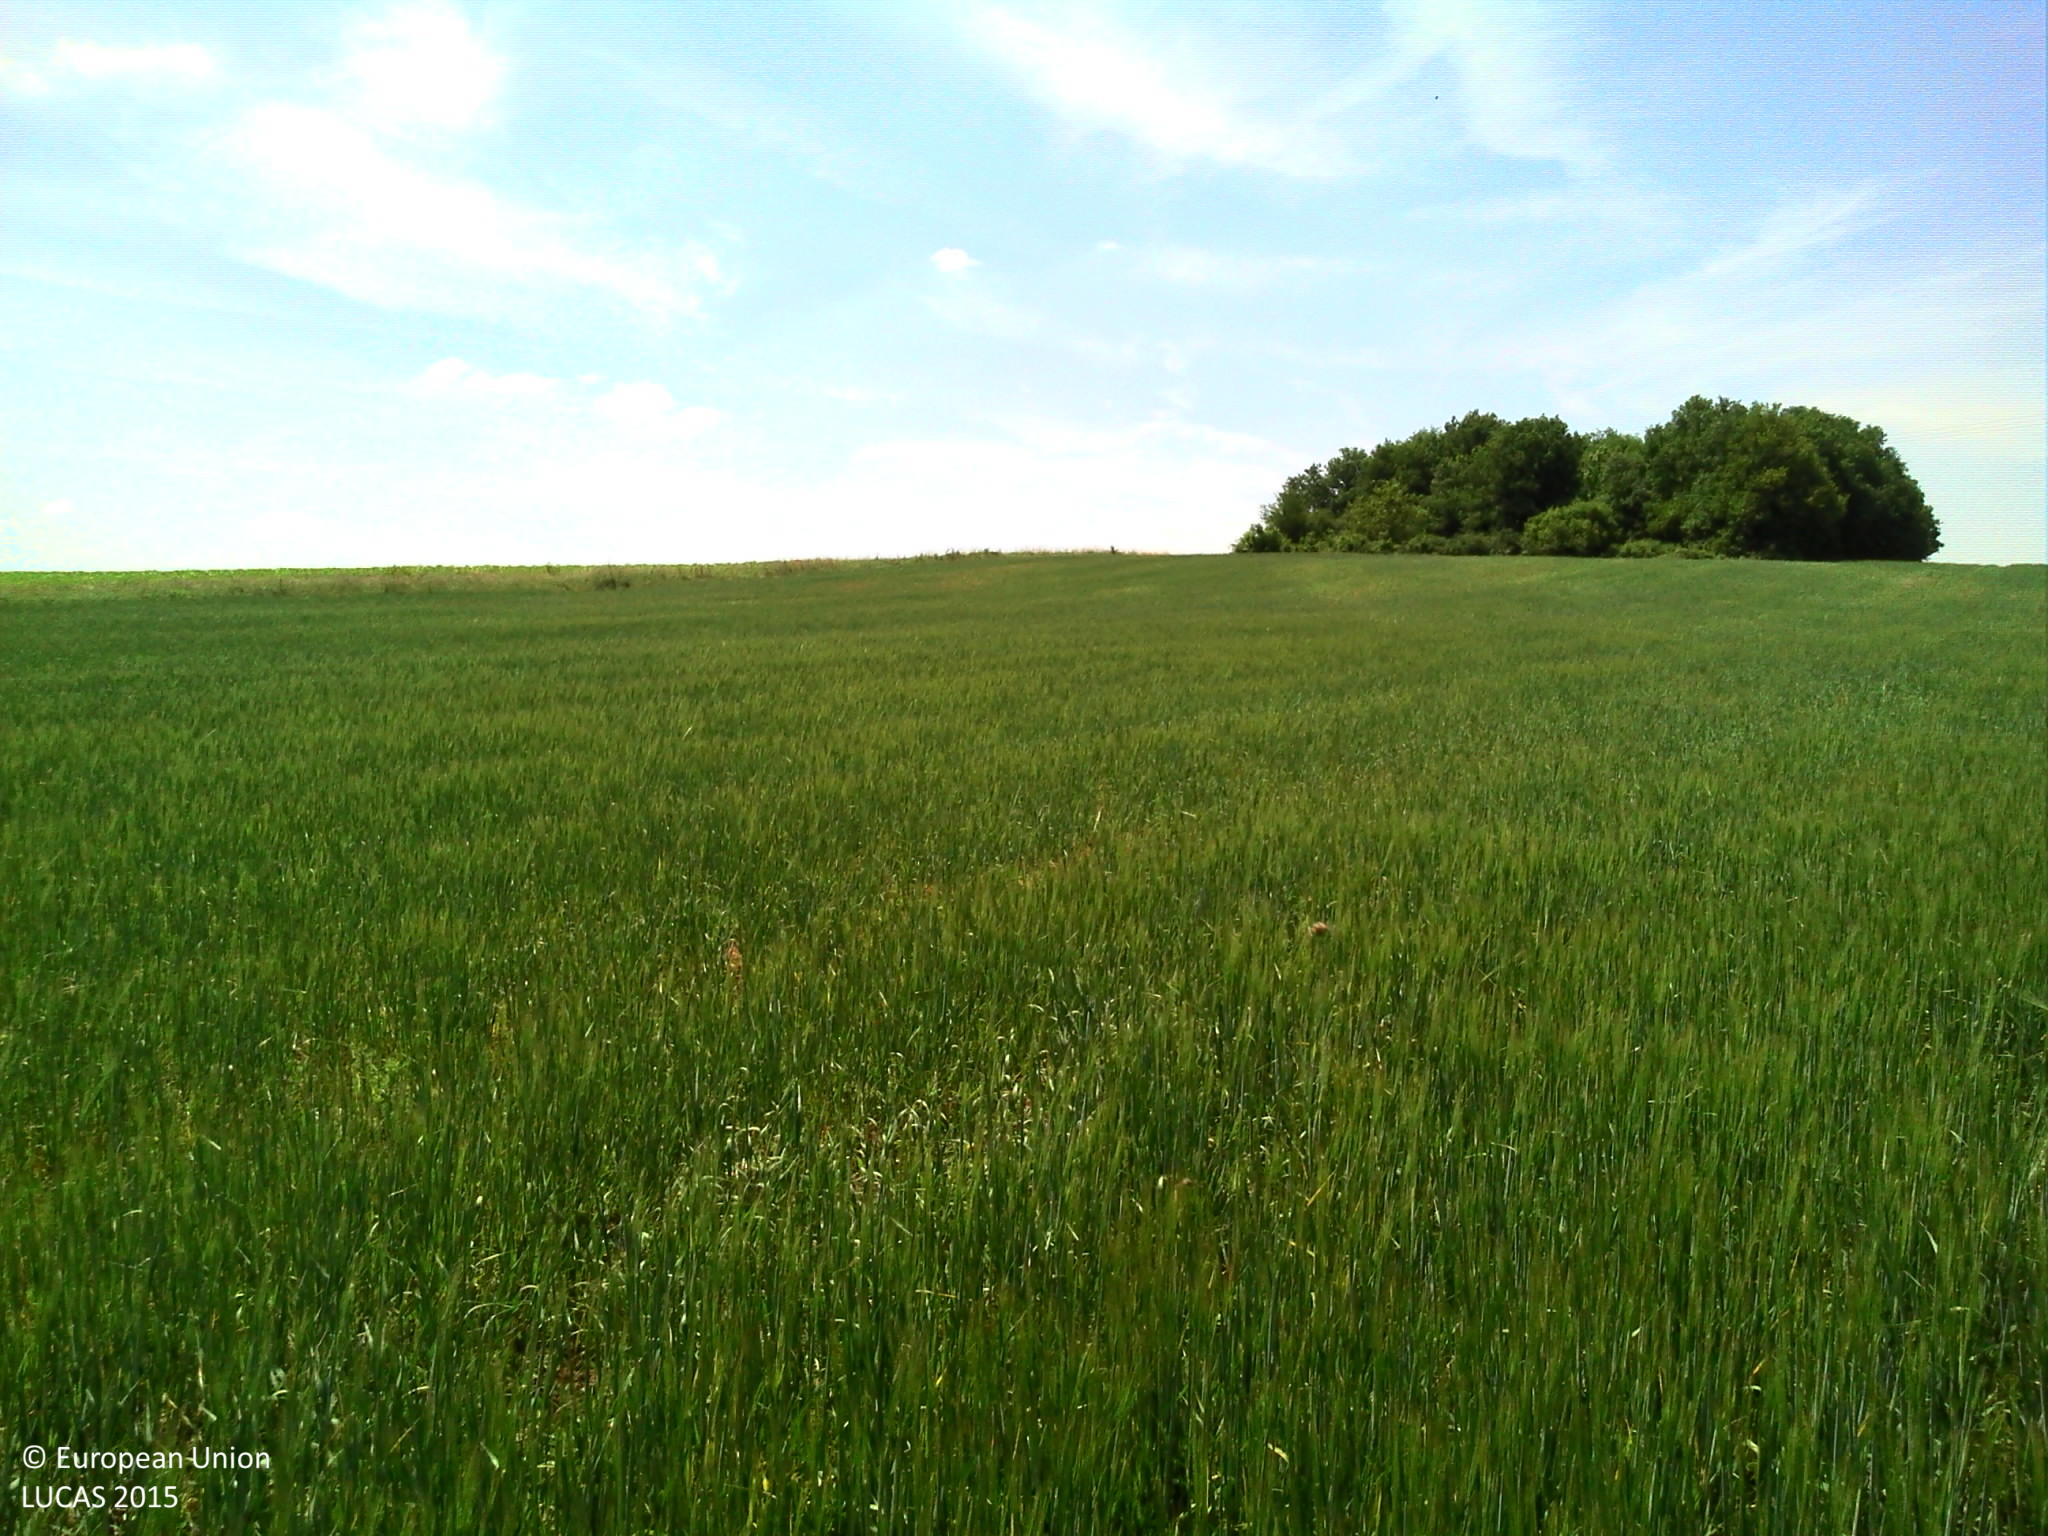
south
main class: Cropland
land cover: Barley
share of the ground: > 75 %
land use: Agriculture (excluding fallow land and kitchen gardens)
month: June
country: FR
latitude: 46.5175
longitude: 0.6116
